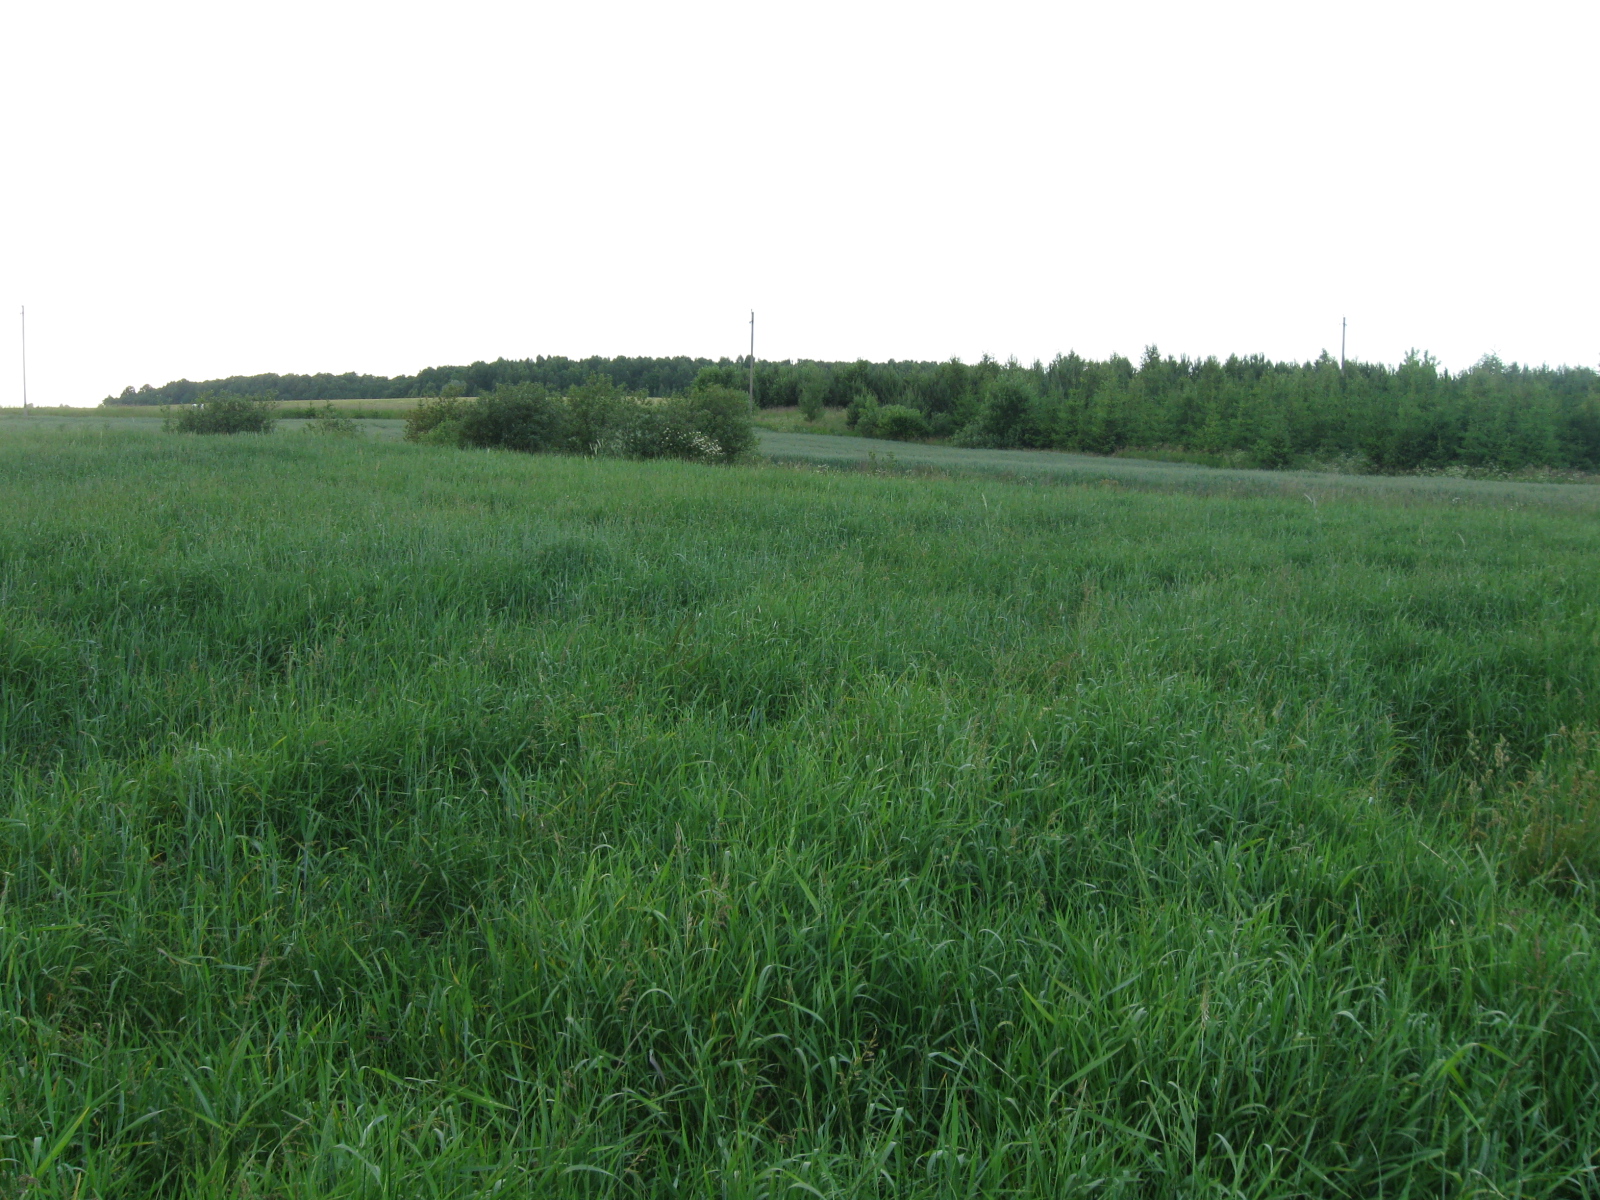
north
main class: Cropland
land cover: Common wheat
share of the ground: > 75 %
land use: Agriculture (excluding fallow land and kitchen gardens)
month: June
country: LT
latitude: 54.8586
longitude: 24.5441
